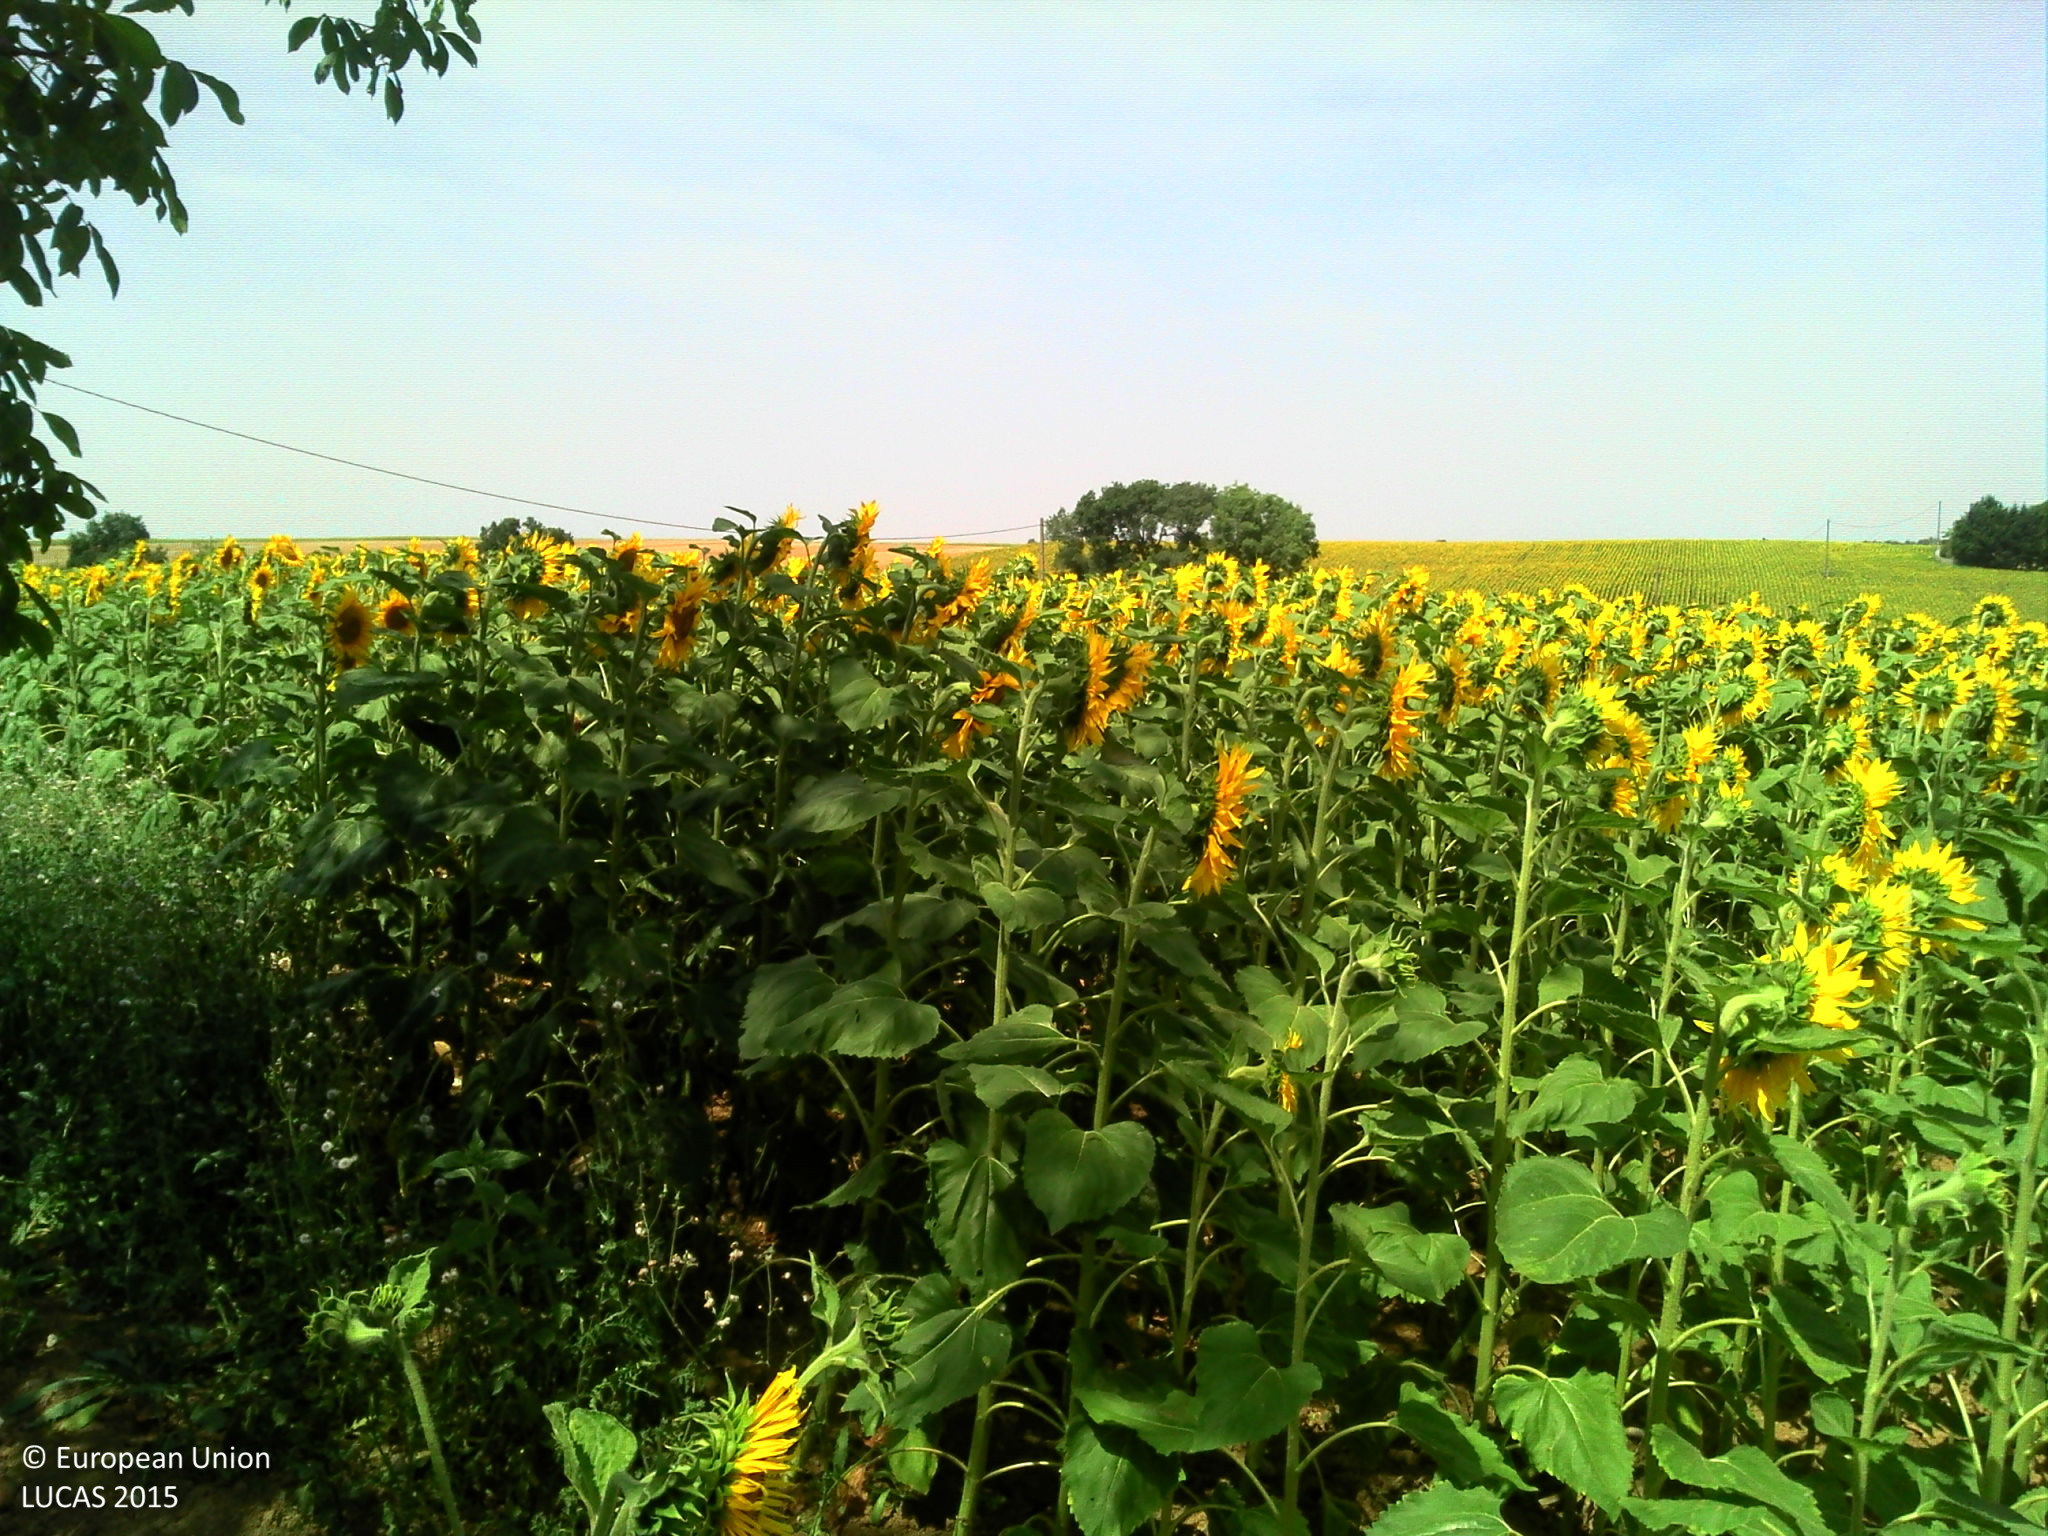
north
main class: Cropland
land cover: Sunflower
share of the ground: > 75 %
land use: Agriculture (excluding fallow land and kitchen gardens)
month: July
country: FR
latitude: 43.6335
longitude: 1.0140
